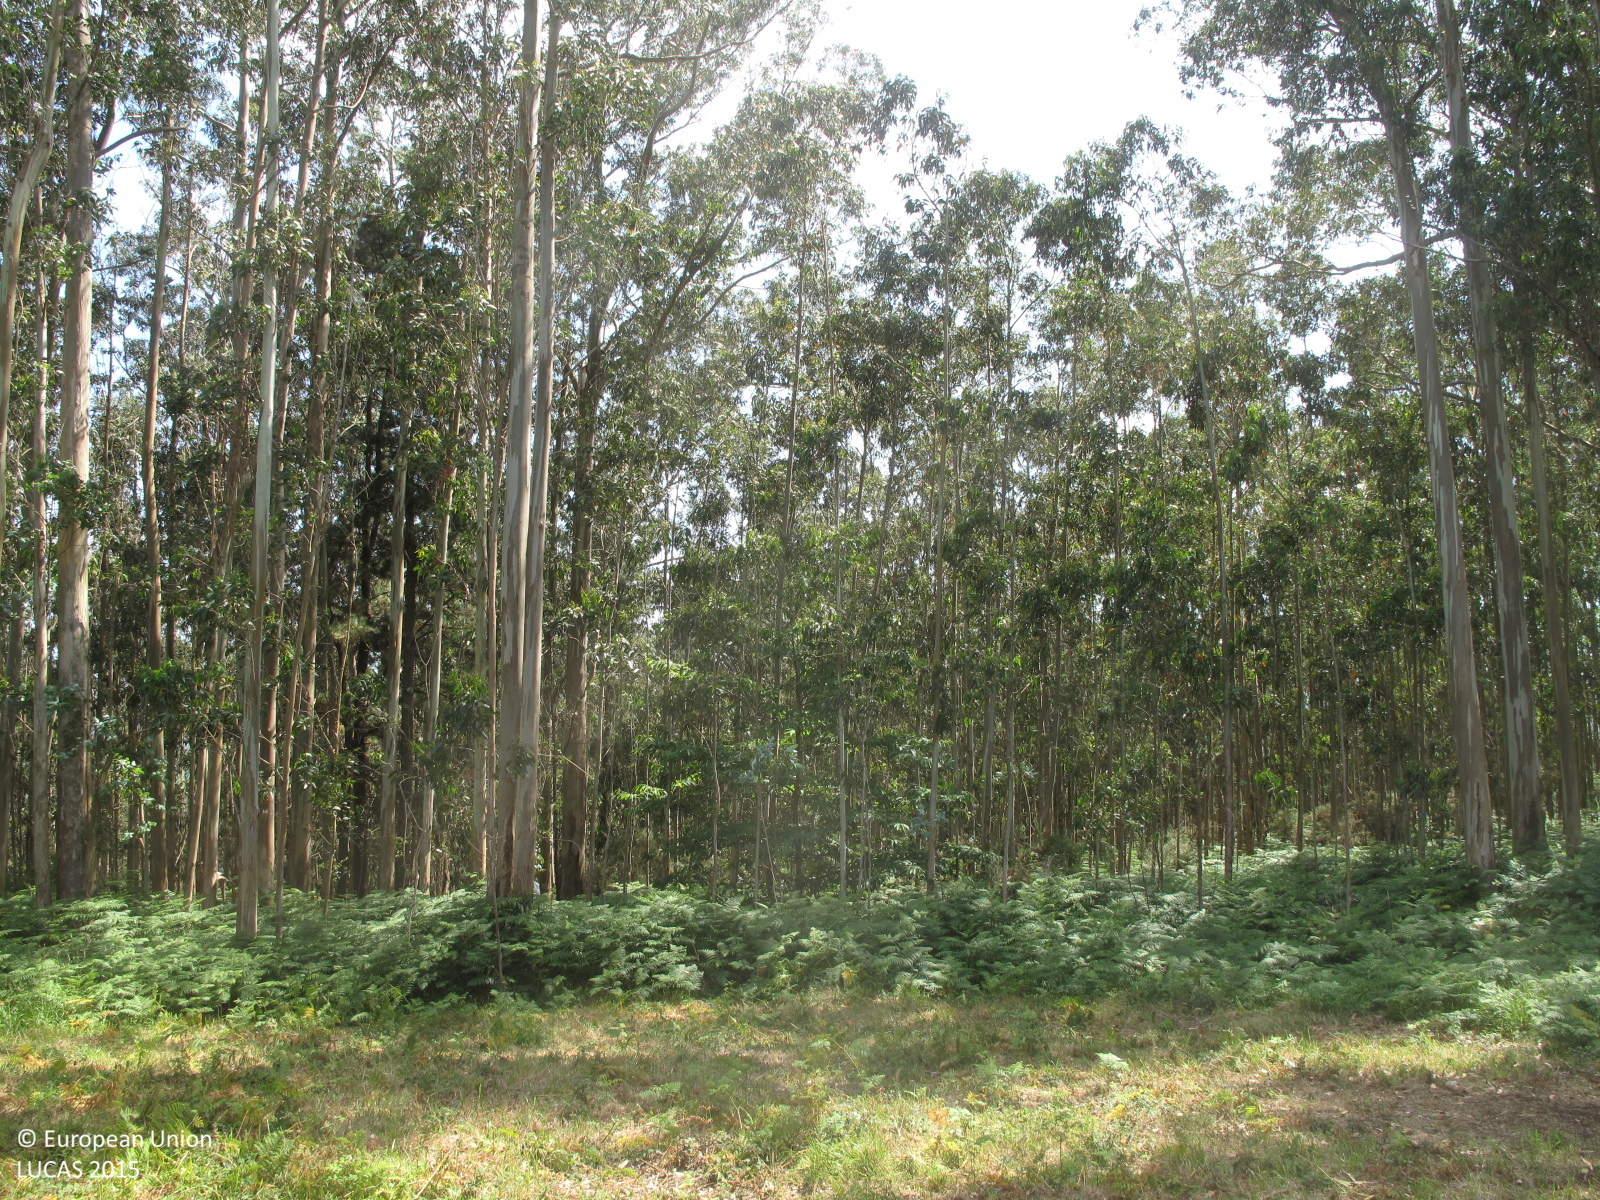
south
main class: Woodland
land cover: Broadleaved woodland
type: exotic forest
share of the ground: 50 - 75 %
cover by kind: broadleaved forest trees 50 %, herbaceous plants 30 %, shrubs 20 %
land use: Forestry
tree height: > 5 m
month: July
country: ES
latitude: 43.6483
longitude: -8.0899
